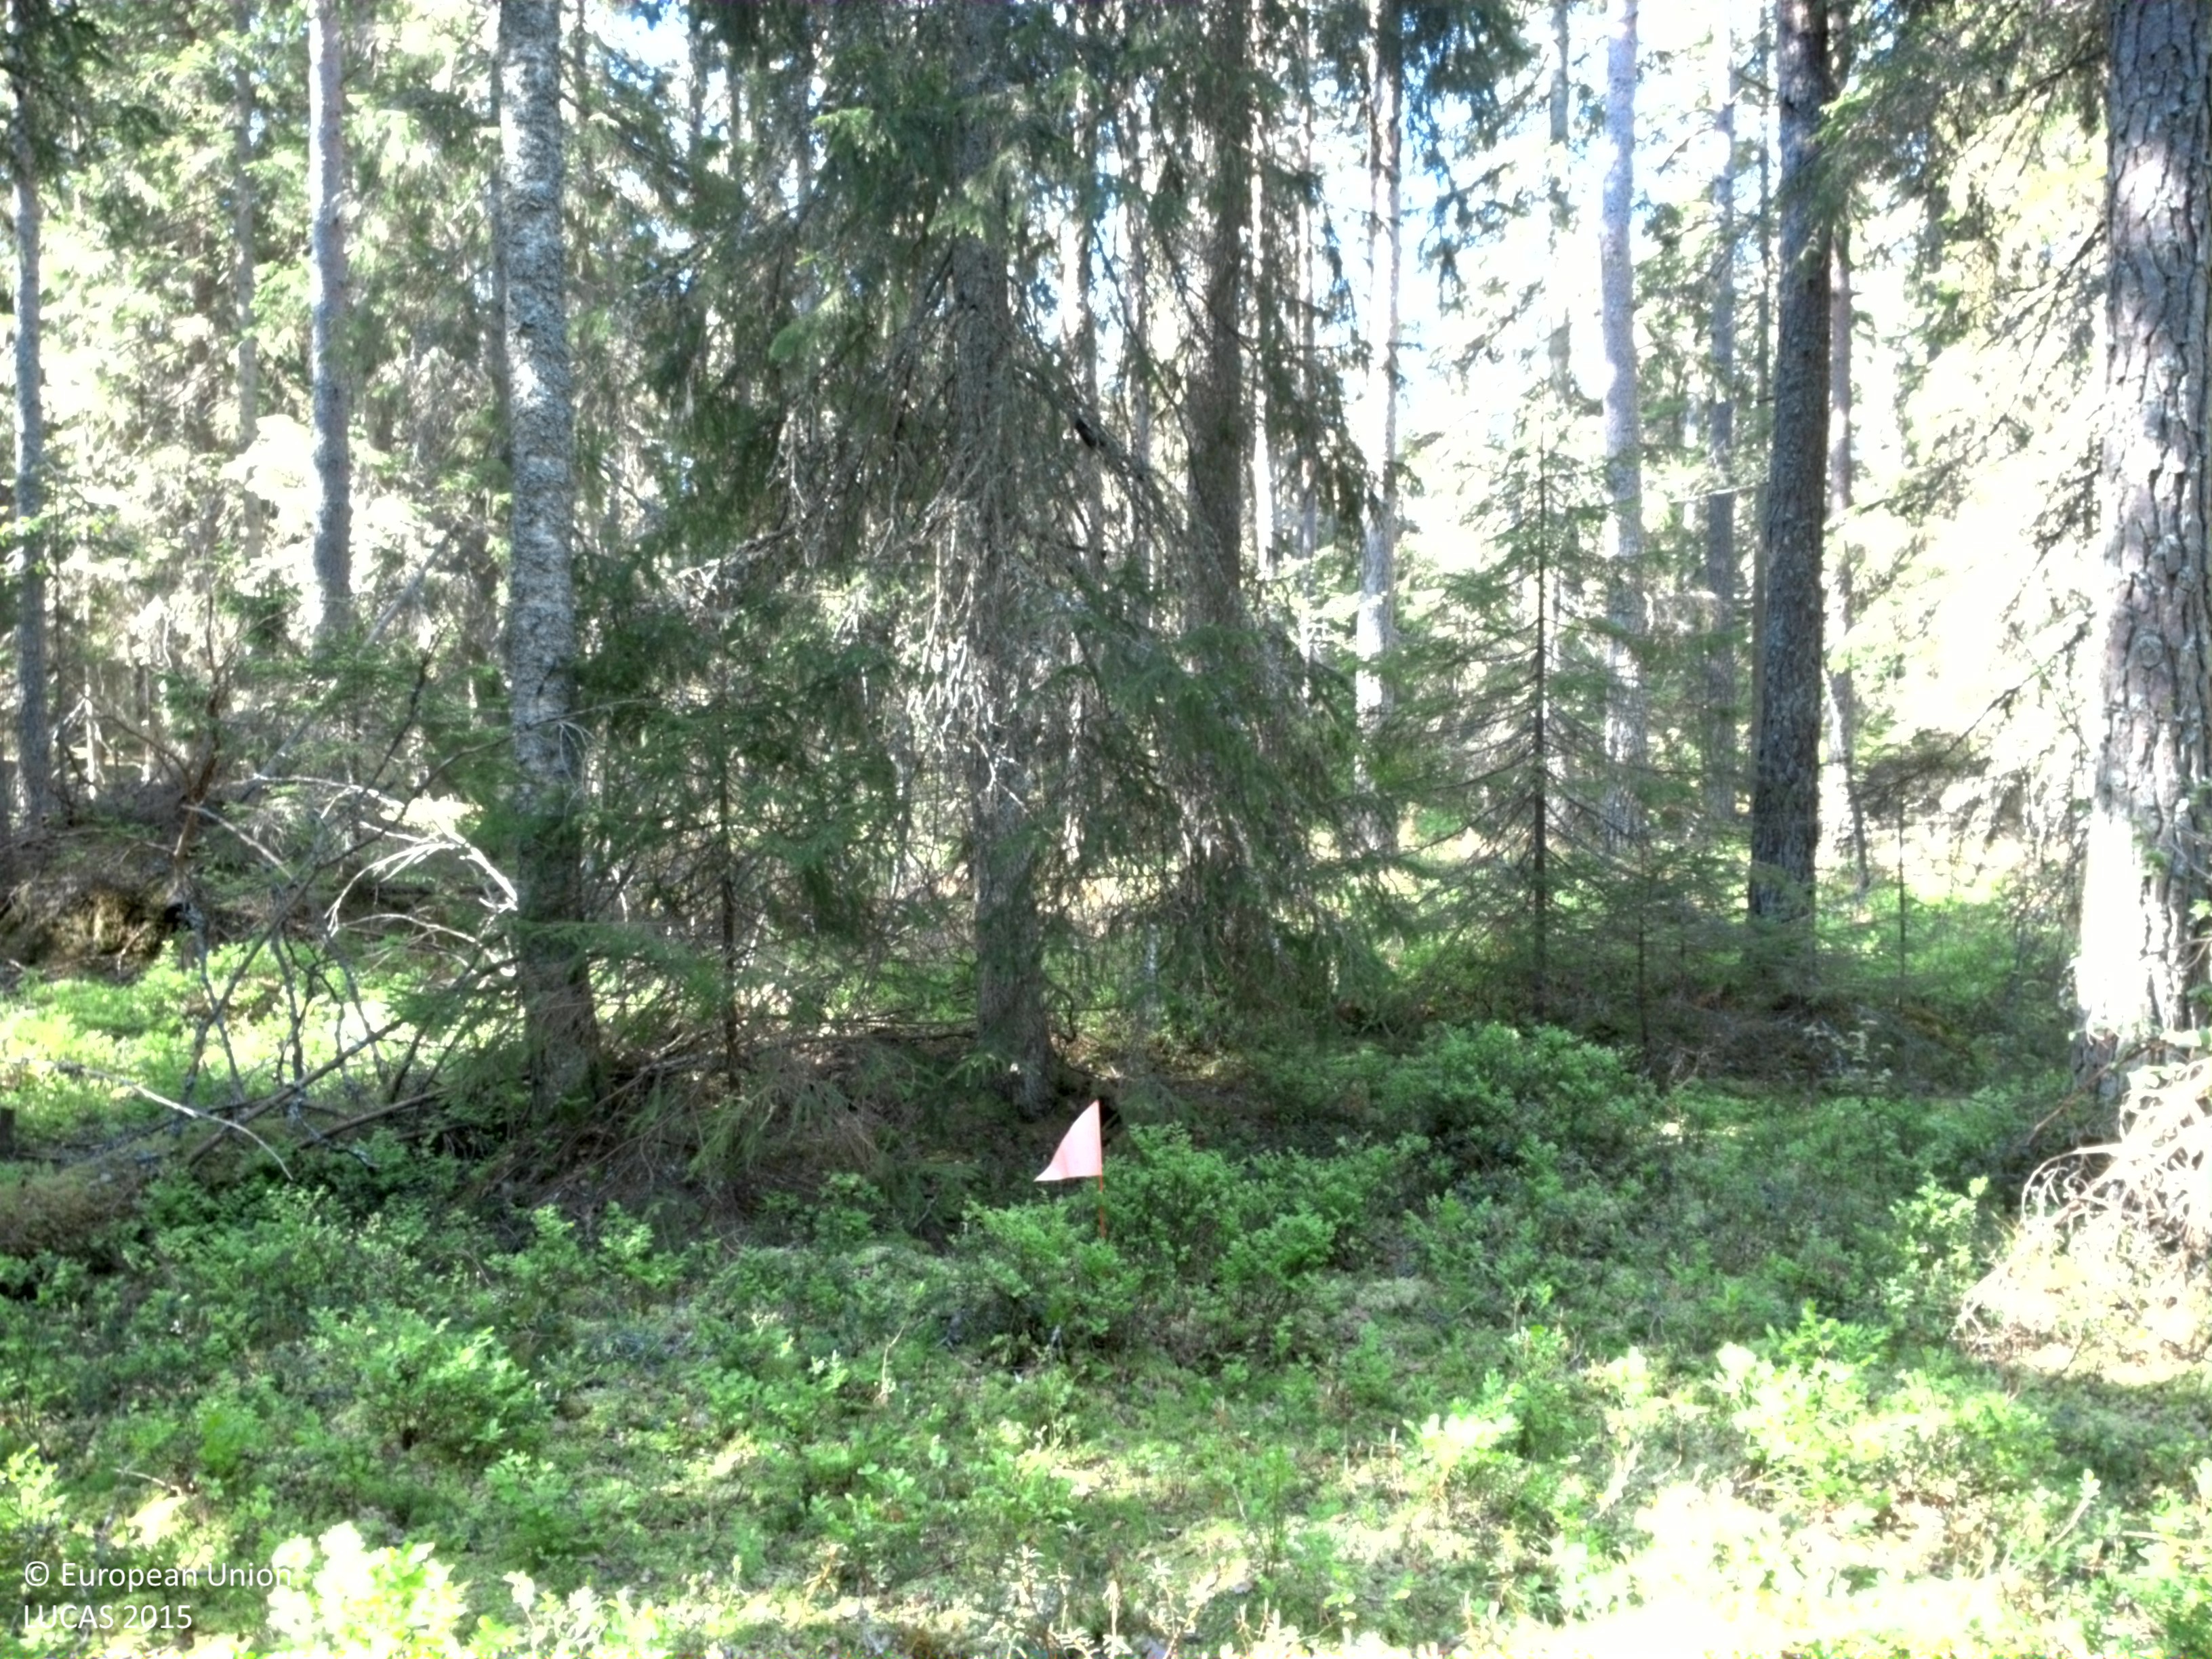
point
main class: Woodland
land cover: Spruce dominated coniferous woodland
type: boreal forest
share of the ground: 50 - 75 %
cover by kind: coniferous forest trees 40 %, shrubs 30 %, lichens and mosses 20 %, broadleaved forest trees 10 %
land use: Forestry
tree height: > 5 m
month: May
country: SE
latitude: 57.3849
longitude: 15.9366
